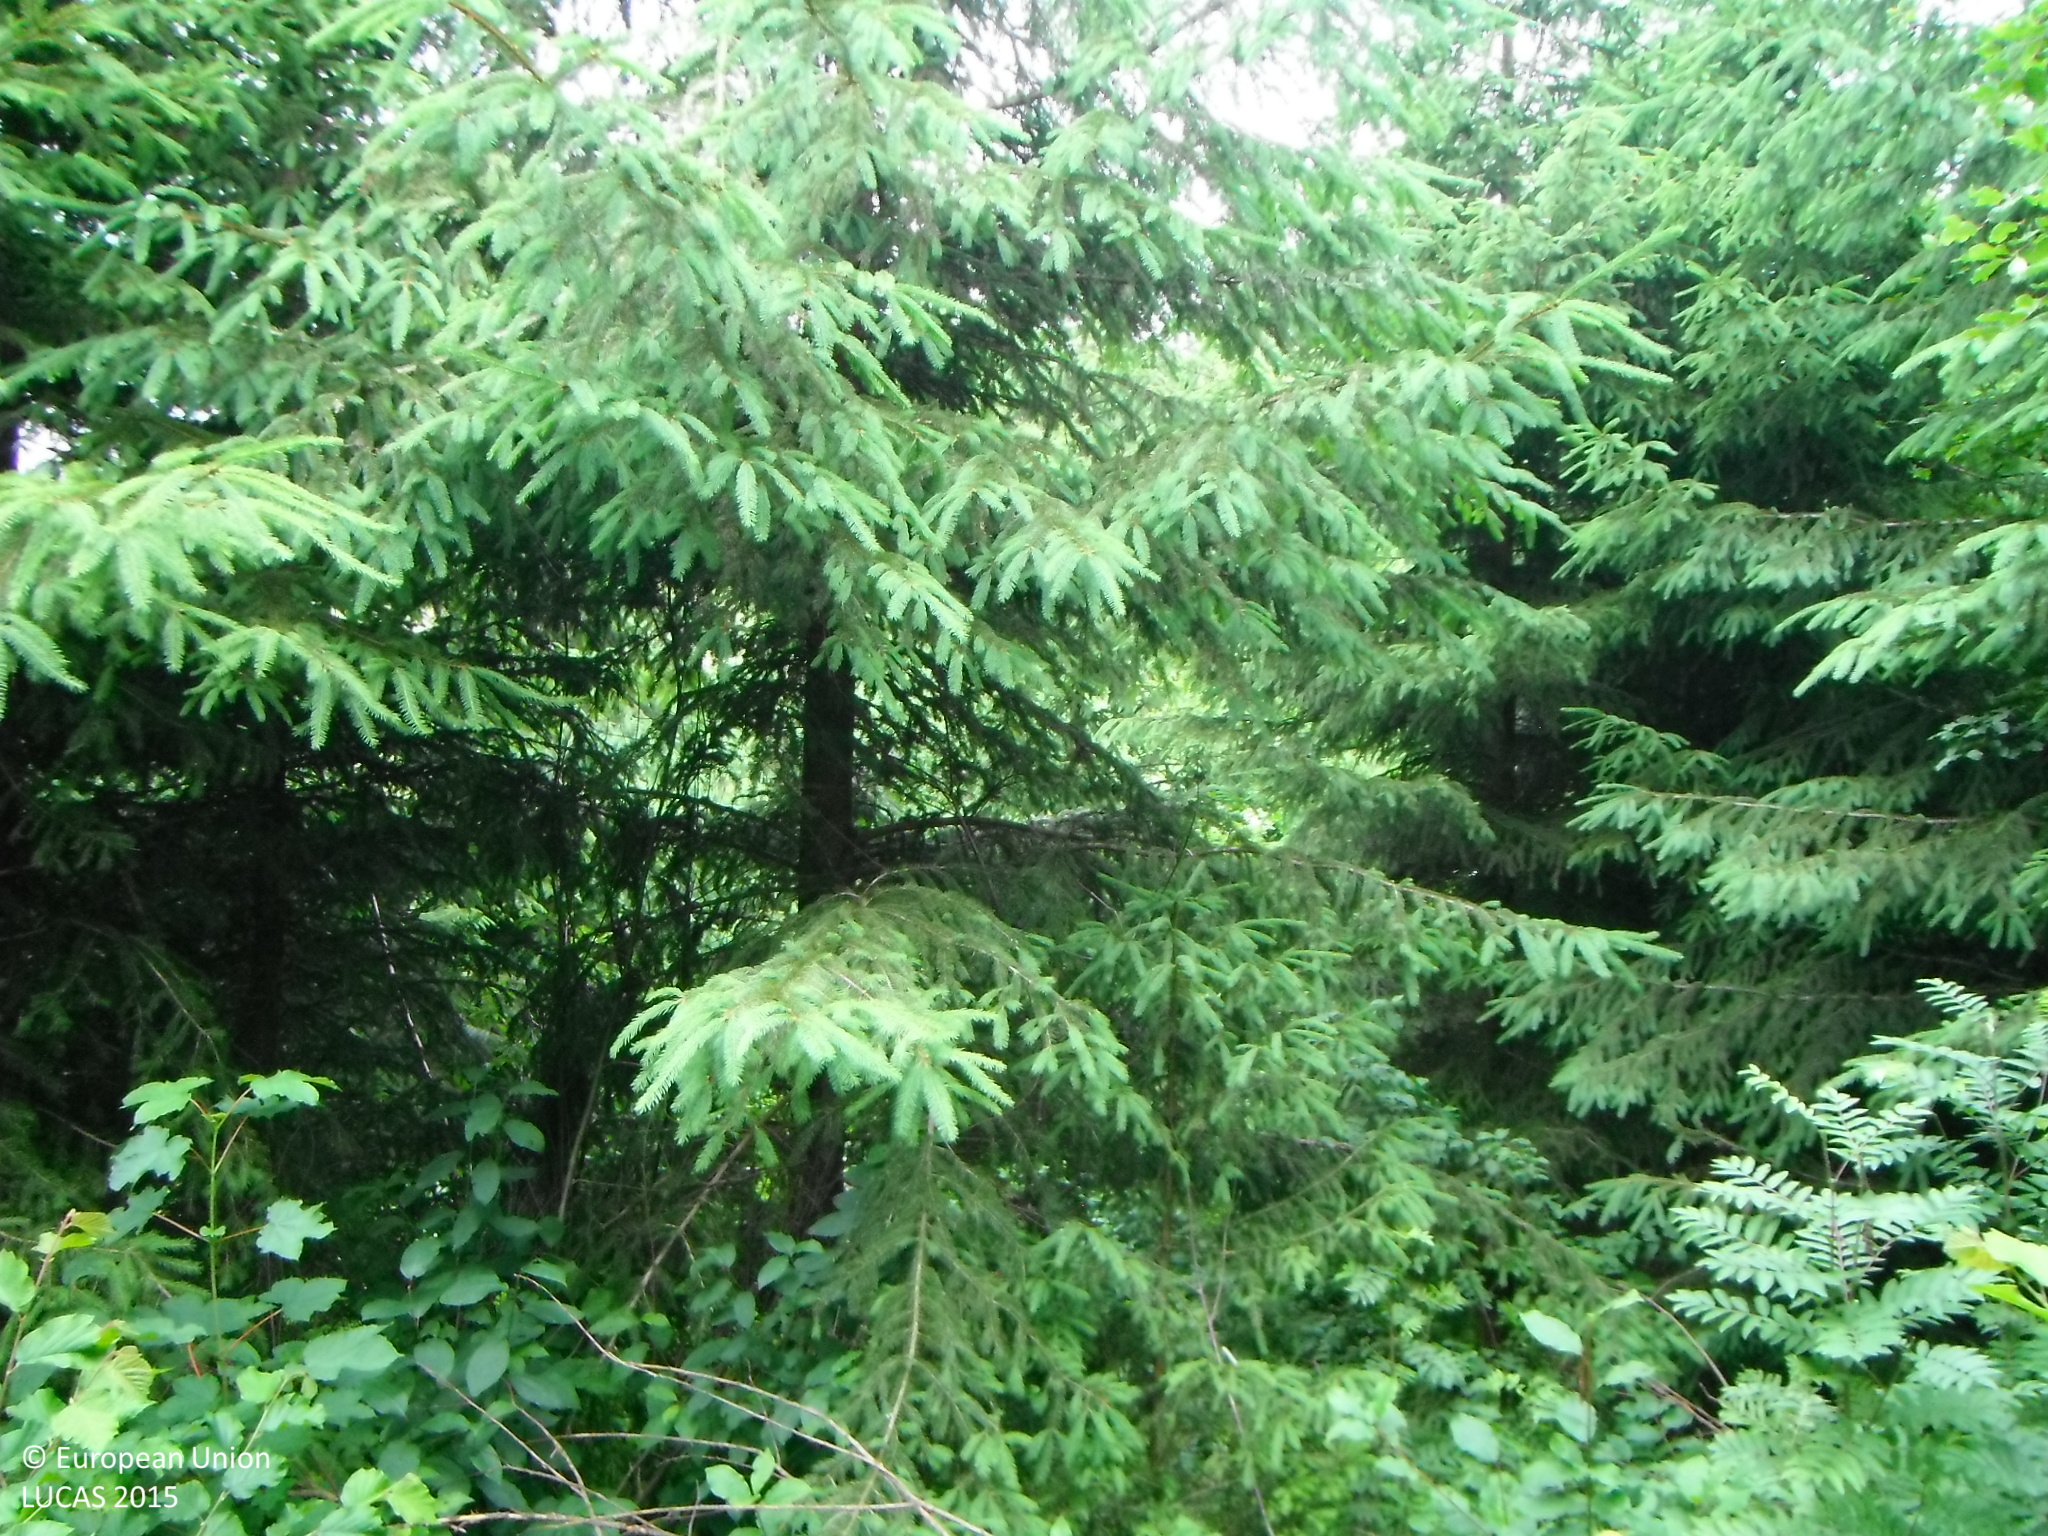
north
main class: Woodland
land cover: Spruce dominated coniferous woodland
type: hemiboreal forest and nemoral coniferous forest and mixed broadleaved-coniferous forest
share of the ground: 50 - 75 %
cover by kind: coniferous forest trees 65 %, shrubs 15 %, herbaceous plants 15 %, broadleaved forest trees 5 %
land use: Forestry
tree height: > 5 m
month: June
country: SK
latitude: 49.2000
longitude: 19.3712
